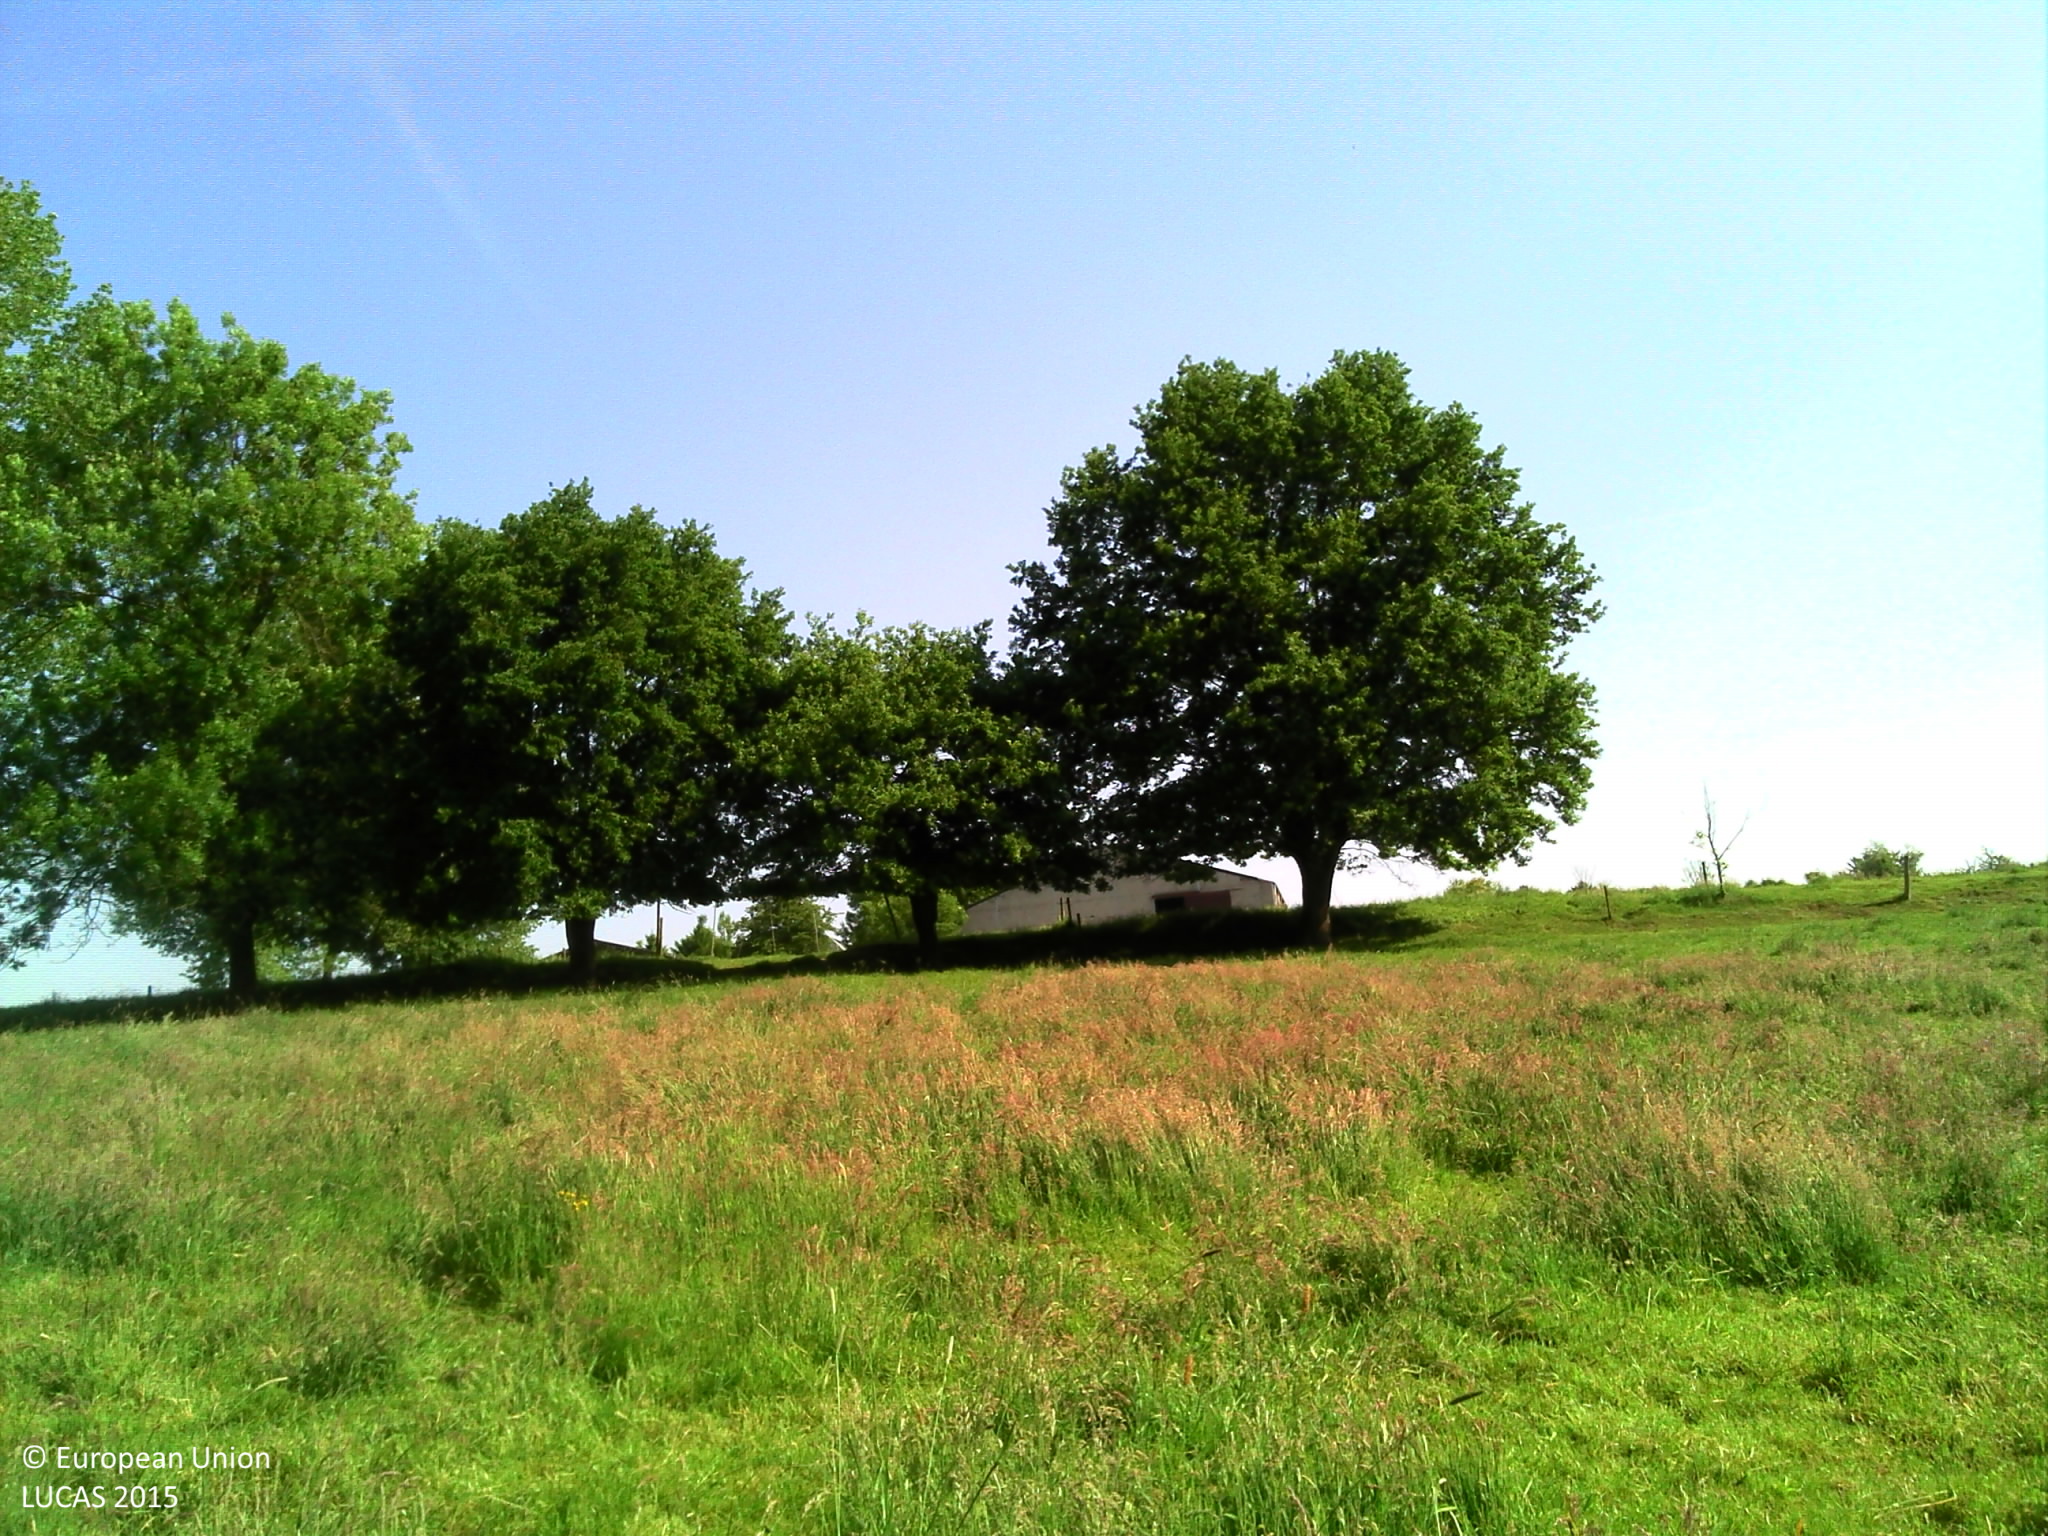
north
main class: Grassland
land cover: Grassland without tree/shrub cover
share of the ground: > 75 %
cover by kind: herbaceous plants 70 %, shrubs 5 %
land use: Agriculture (excluding fallow land and kitchen gardens)
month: May
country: BE
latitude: 50.7146
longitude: 4.0602
